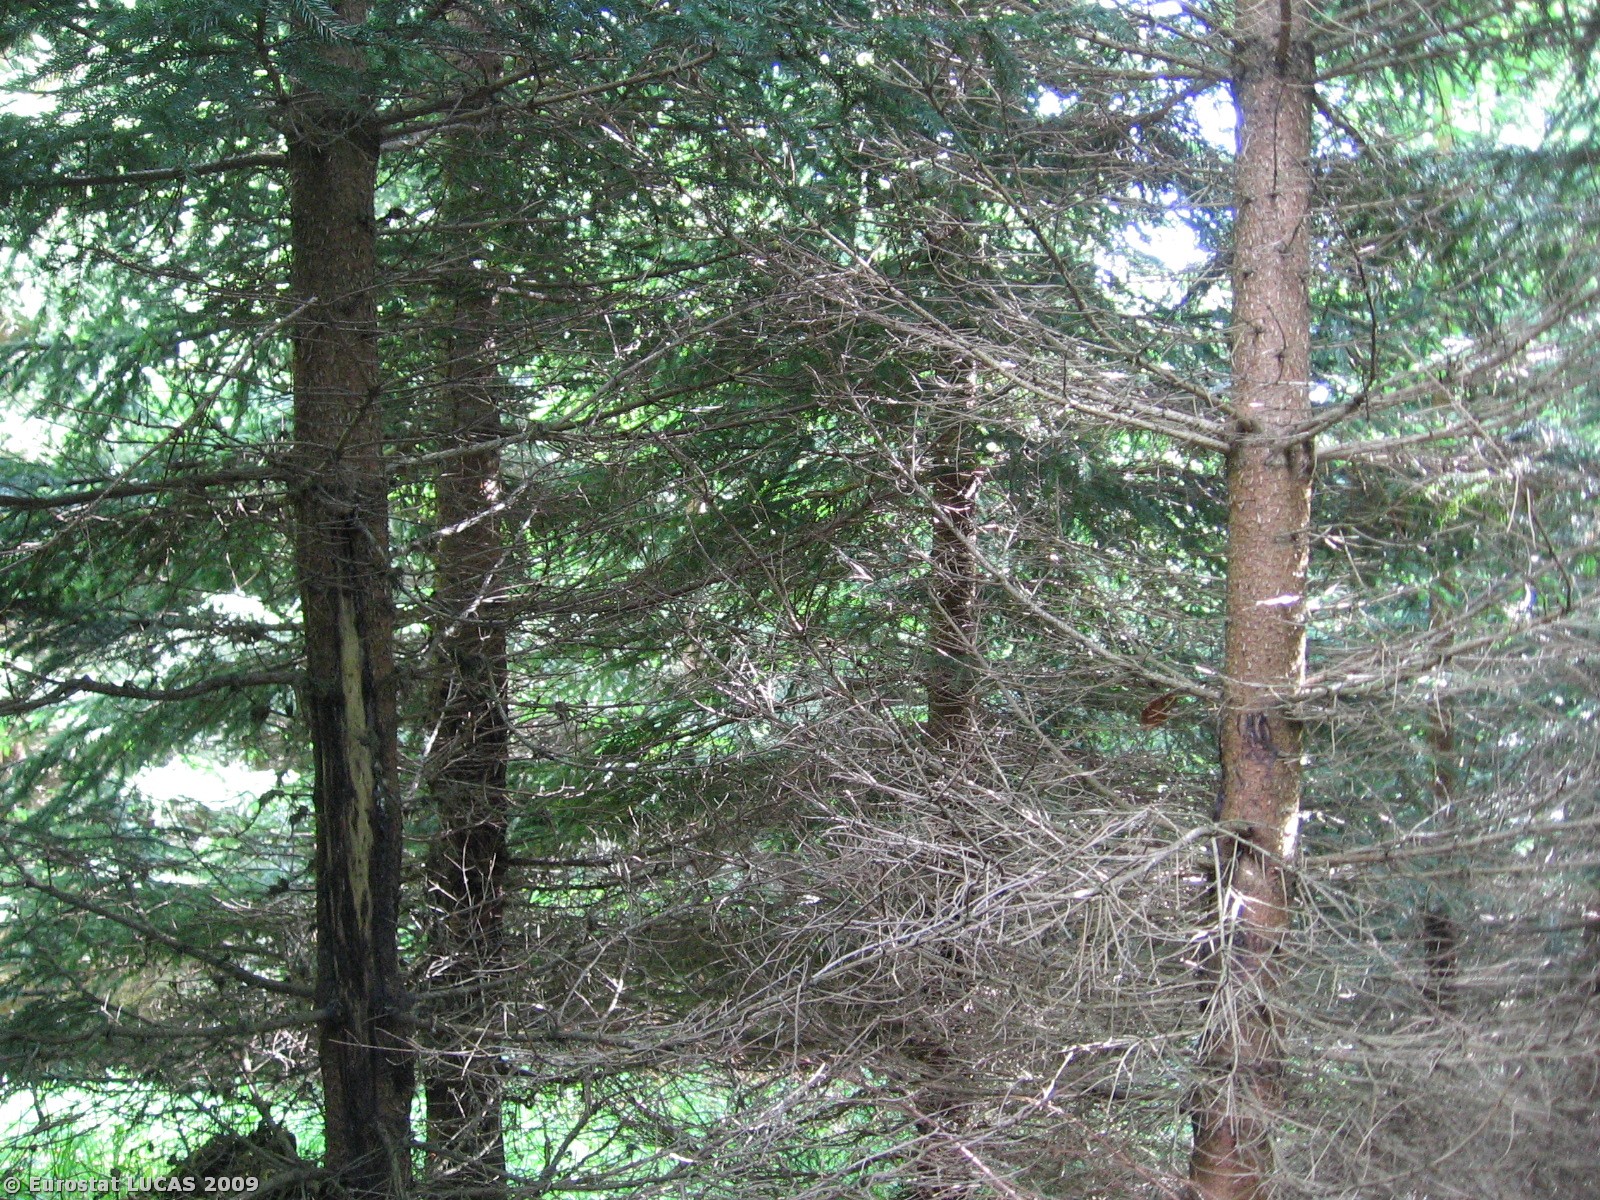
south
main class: Woodland
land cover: Coniferous woodland
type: hemiboreal forest and nemoral coniferous forest and mixed broadleaved-coniferous forest
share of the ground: > 75 %
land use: Forestry
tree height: > 5 m
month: June
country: CZ
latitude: 48.9673
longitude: 13.8386
